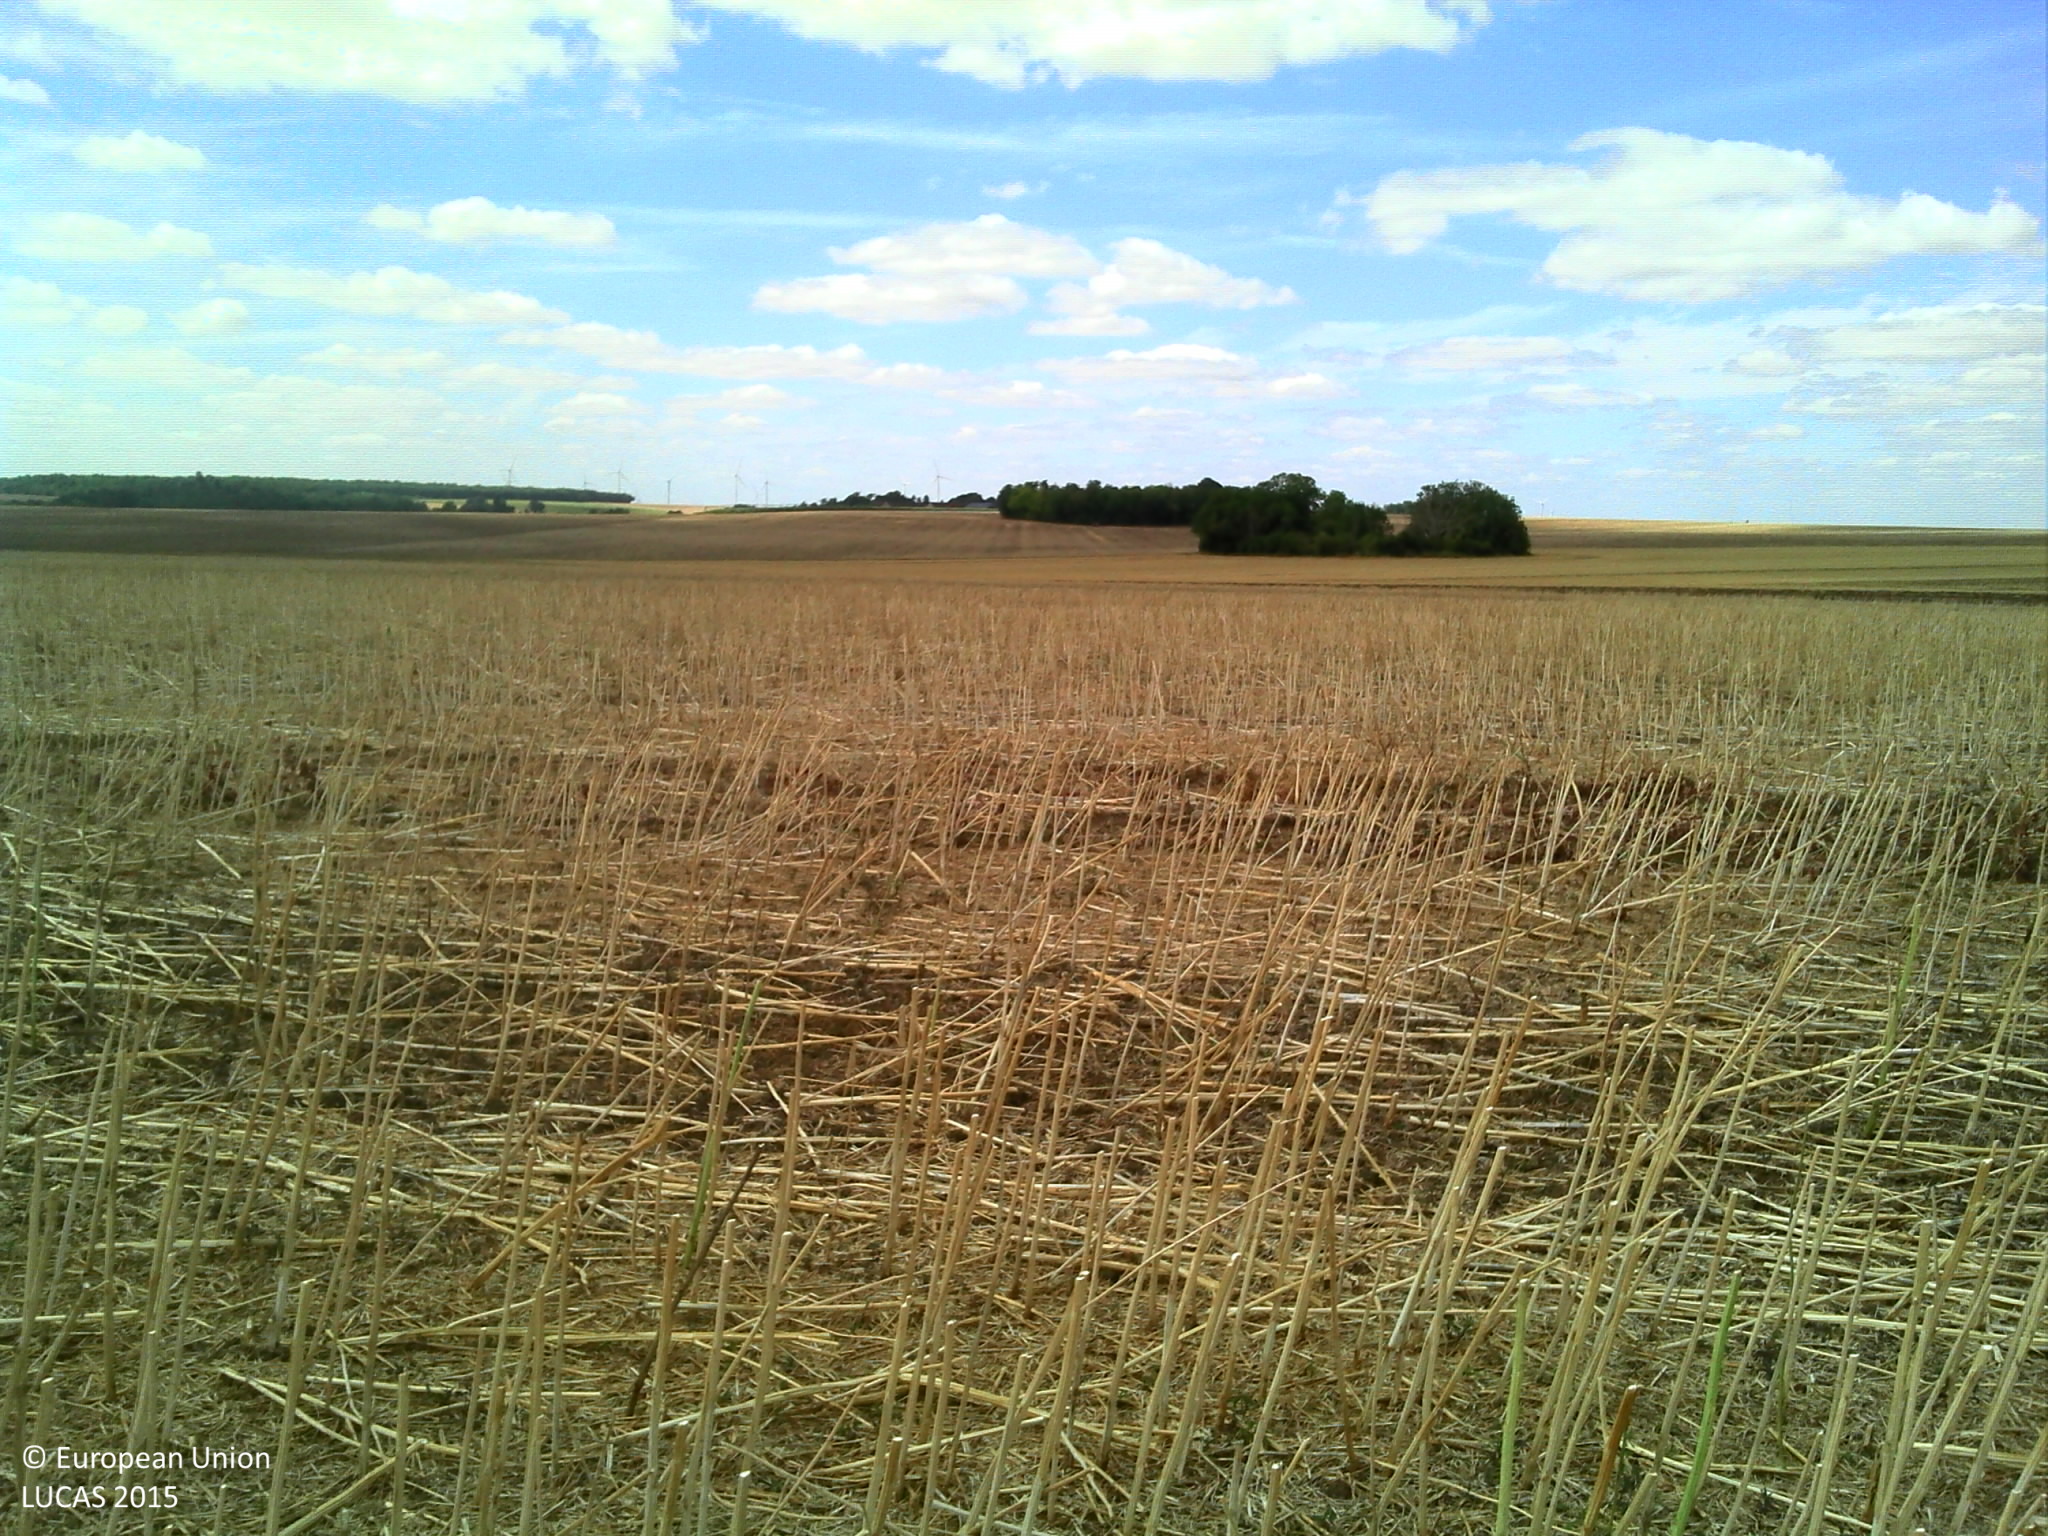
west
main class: Cropland
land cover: Rape and turnip rape
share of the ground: 25 - 50 %
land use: Agriculture (excluding fallow land and kitchen gardens)
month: July
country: FR
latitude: 46.9666
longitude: 2.1454
